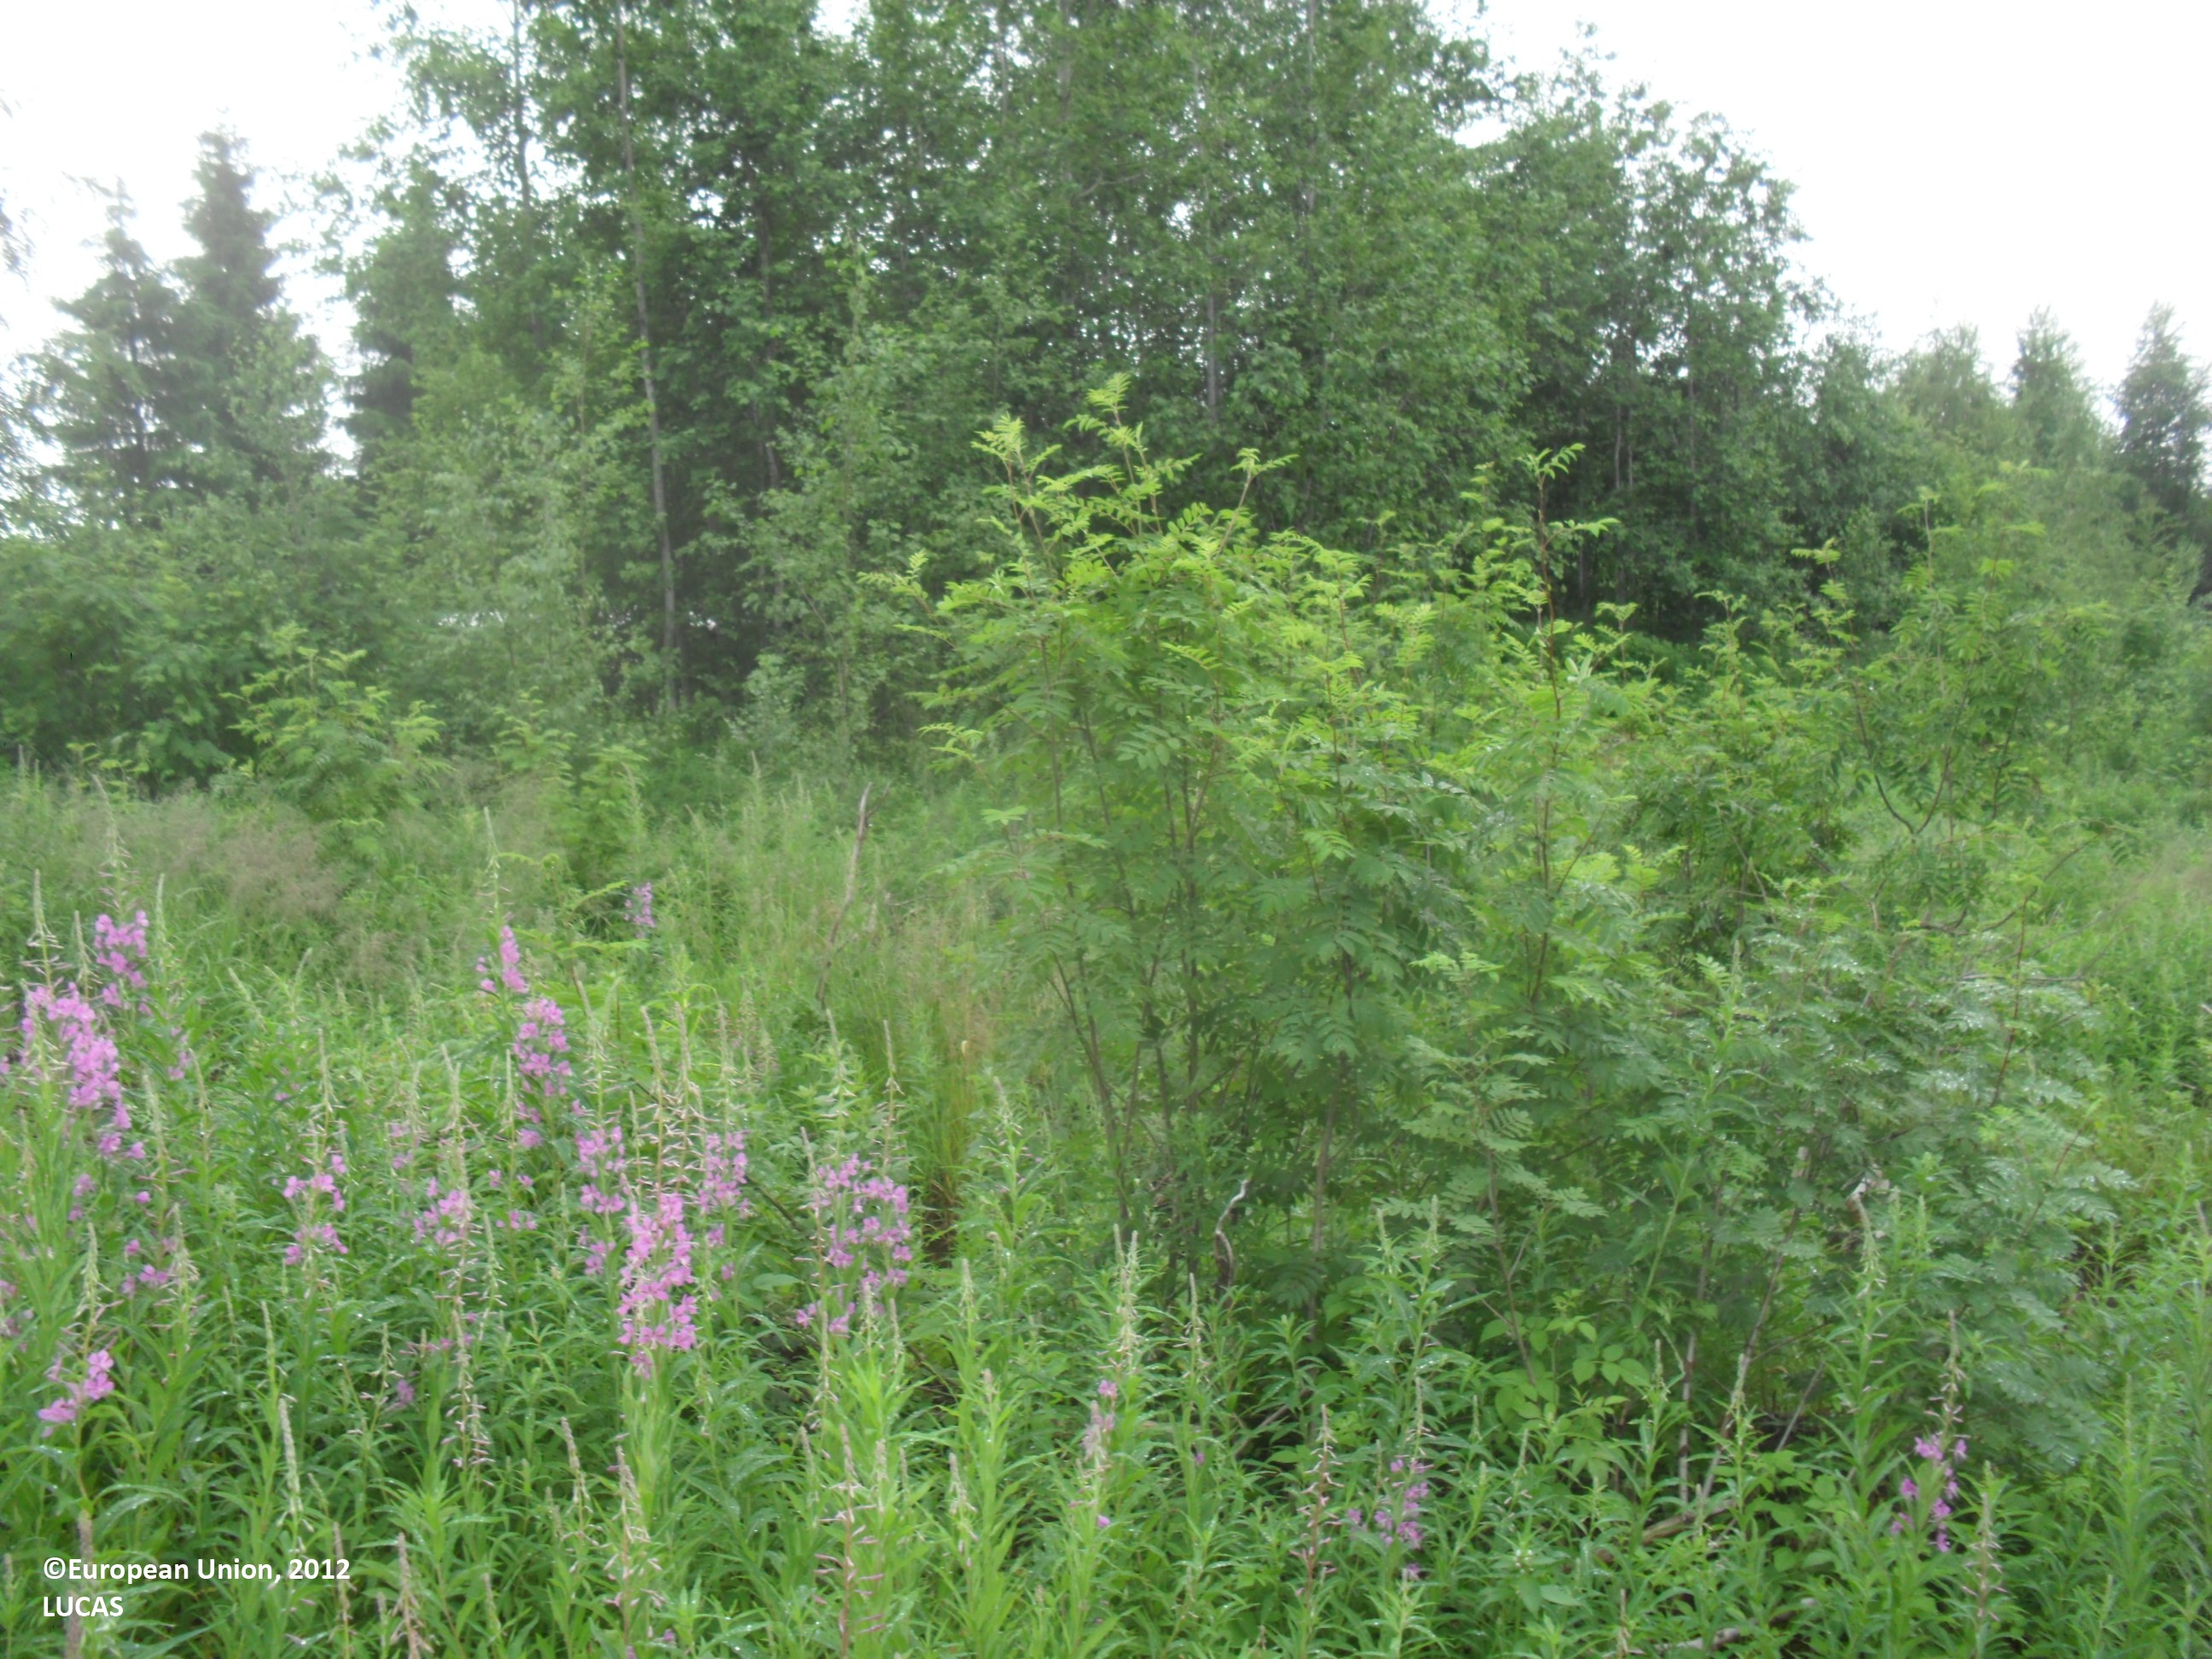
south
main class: Shrubland
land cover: Shrubland with sparse tree cover
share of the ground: 50 - 75 %
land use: Forestry
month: July
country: FI
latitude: 63.4352
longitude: 23.6743
